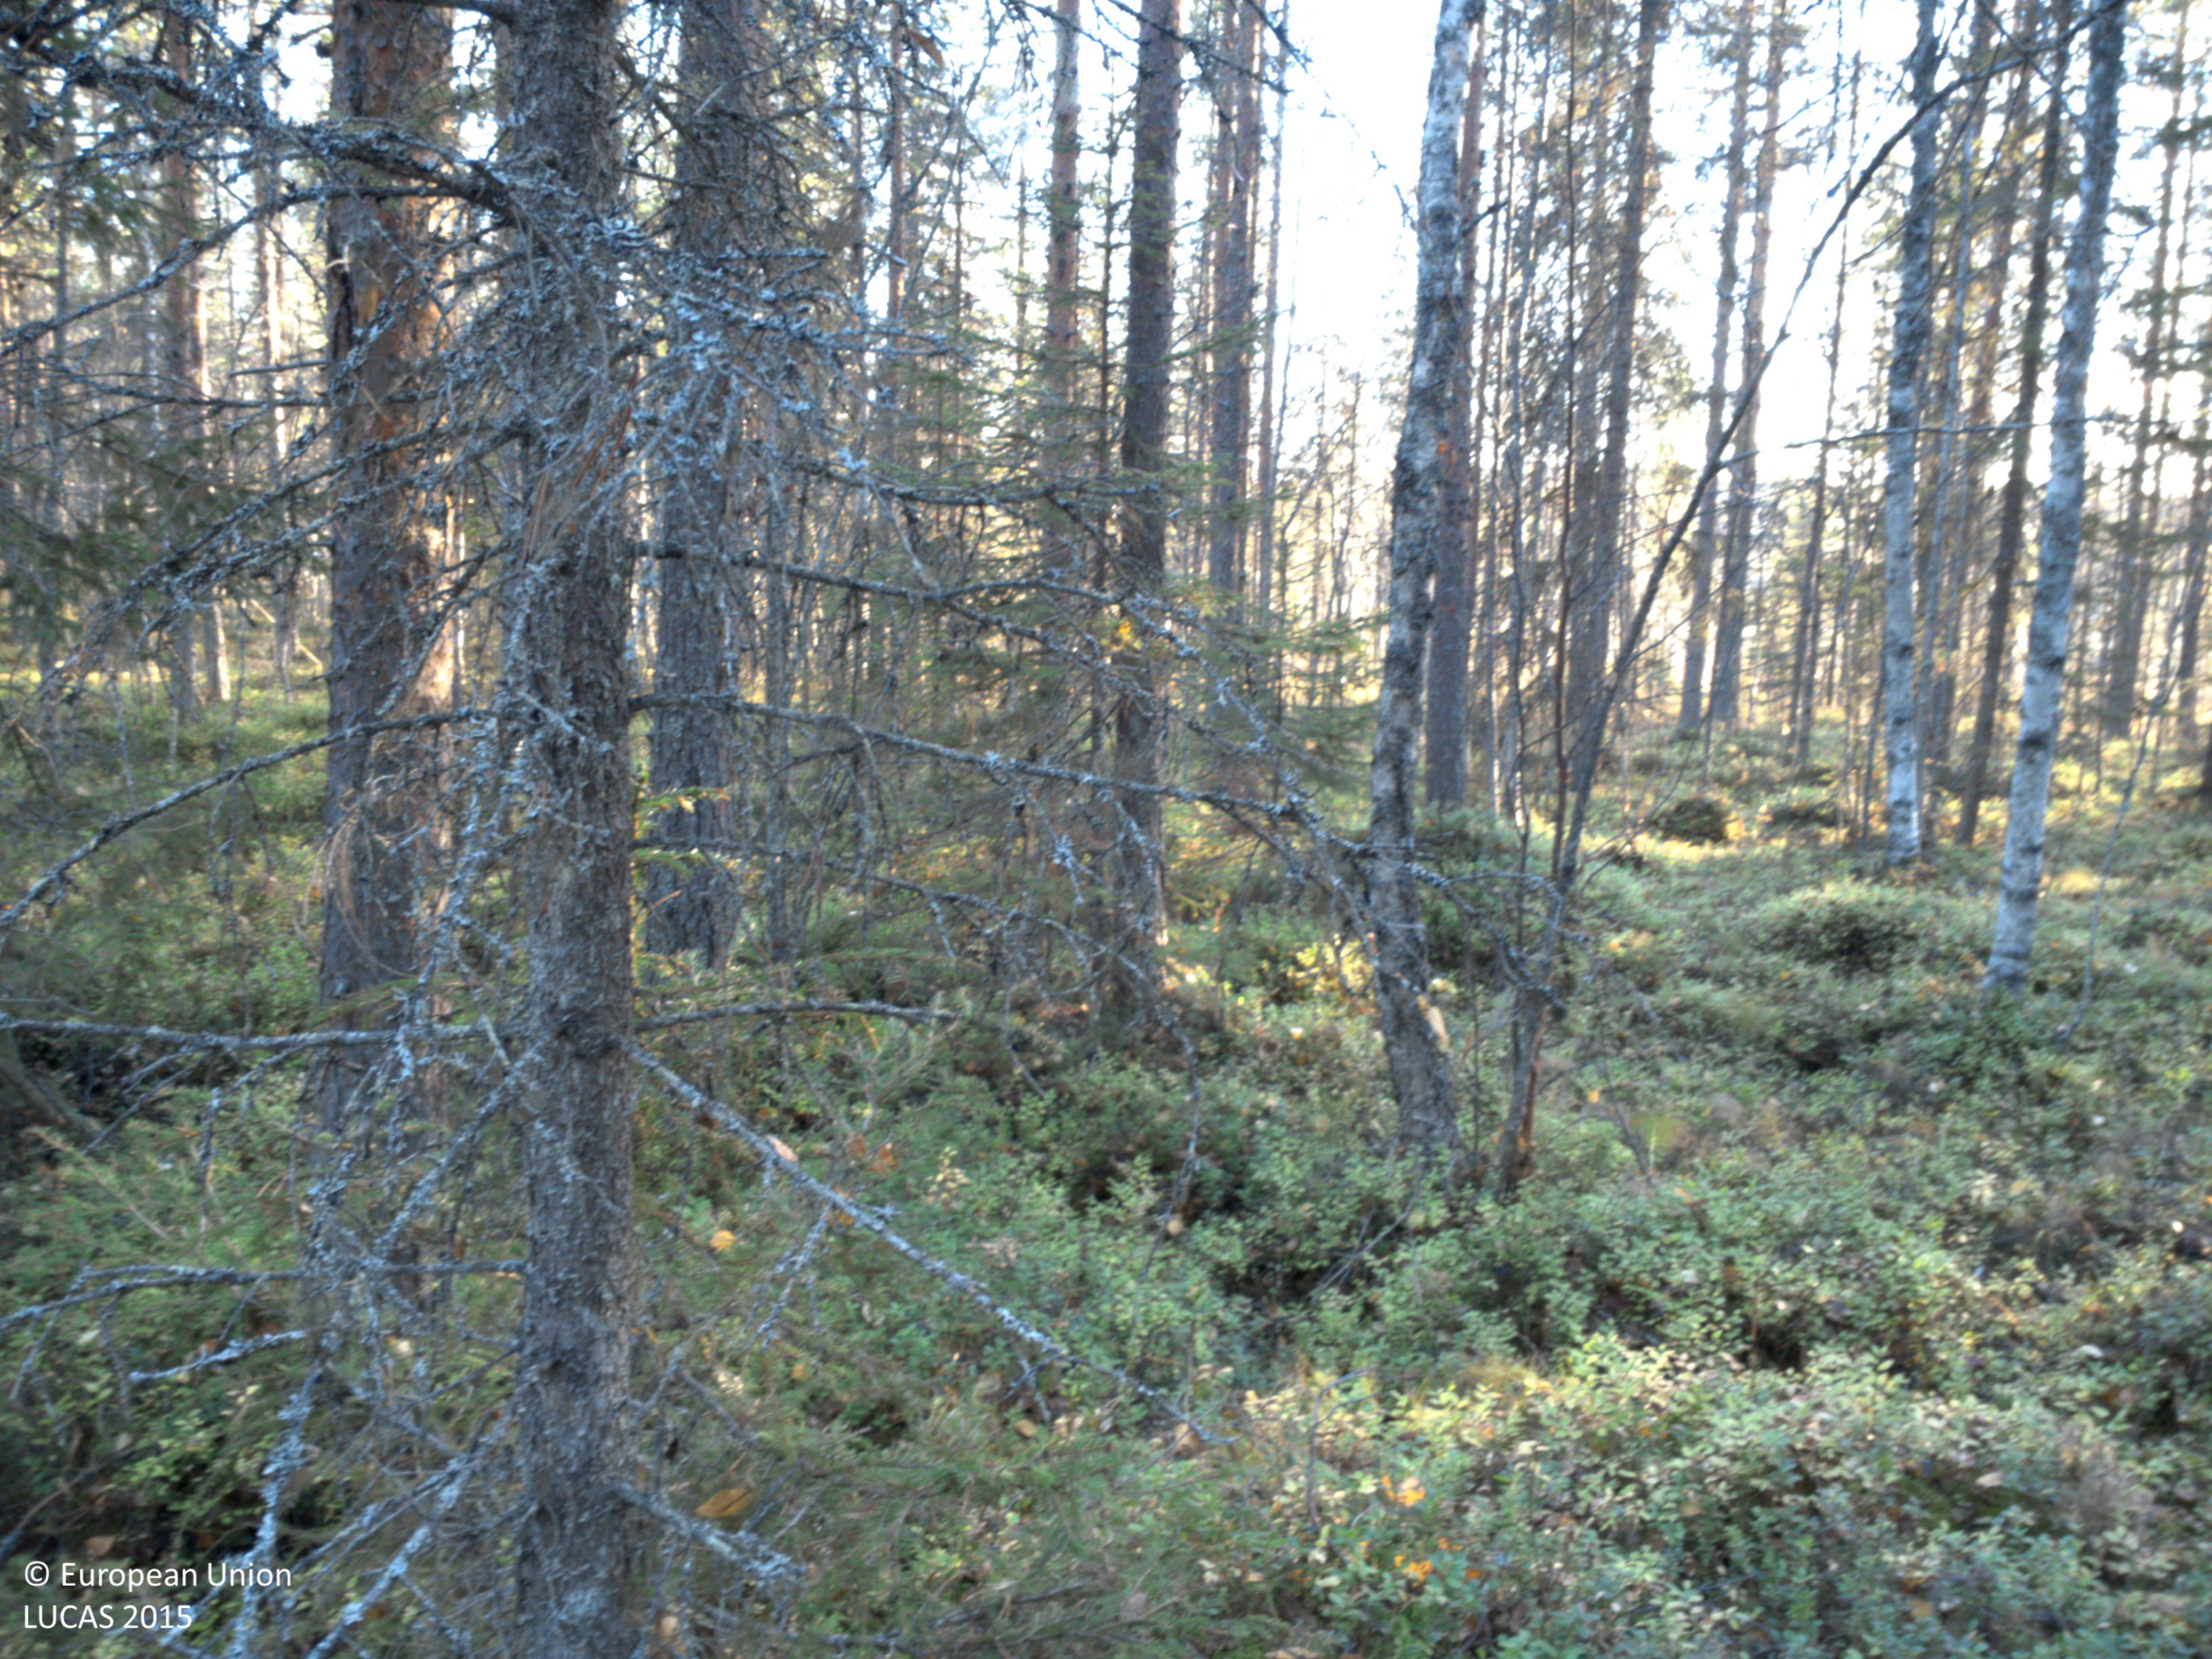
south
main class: Woodland
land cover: Pine dominated mixed woodland
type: boreal forest
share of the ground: 50 - 75 %
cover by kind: coniferous forest trees 45 %, shrubs 40 %, broadleaved forest trees 15 %
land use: Forestry
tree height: > 5 m
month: September
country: SE
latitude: 64.9430
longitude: 18.3233
